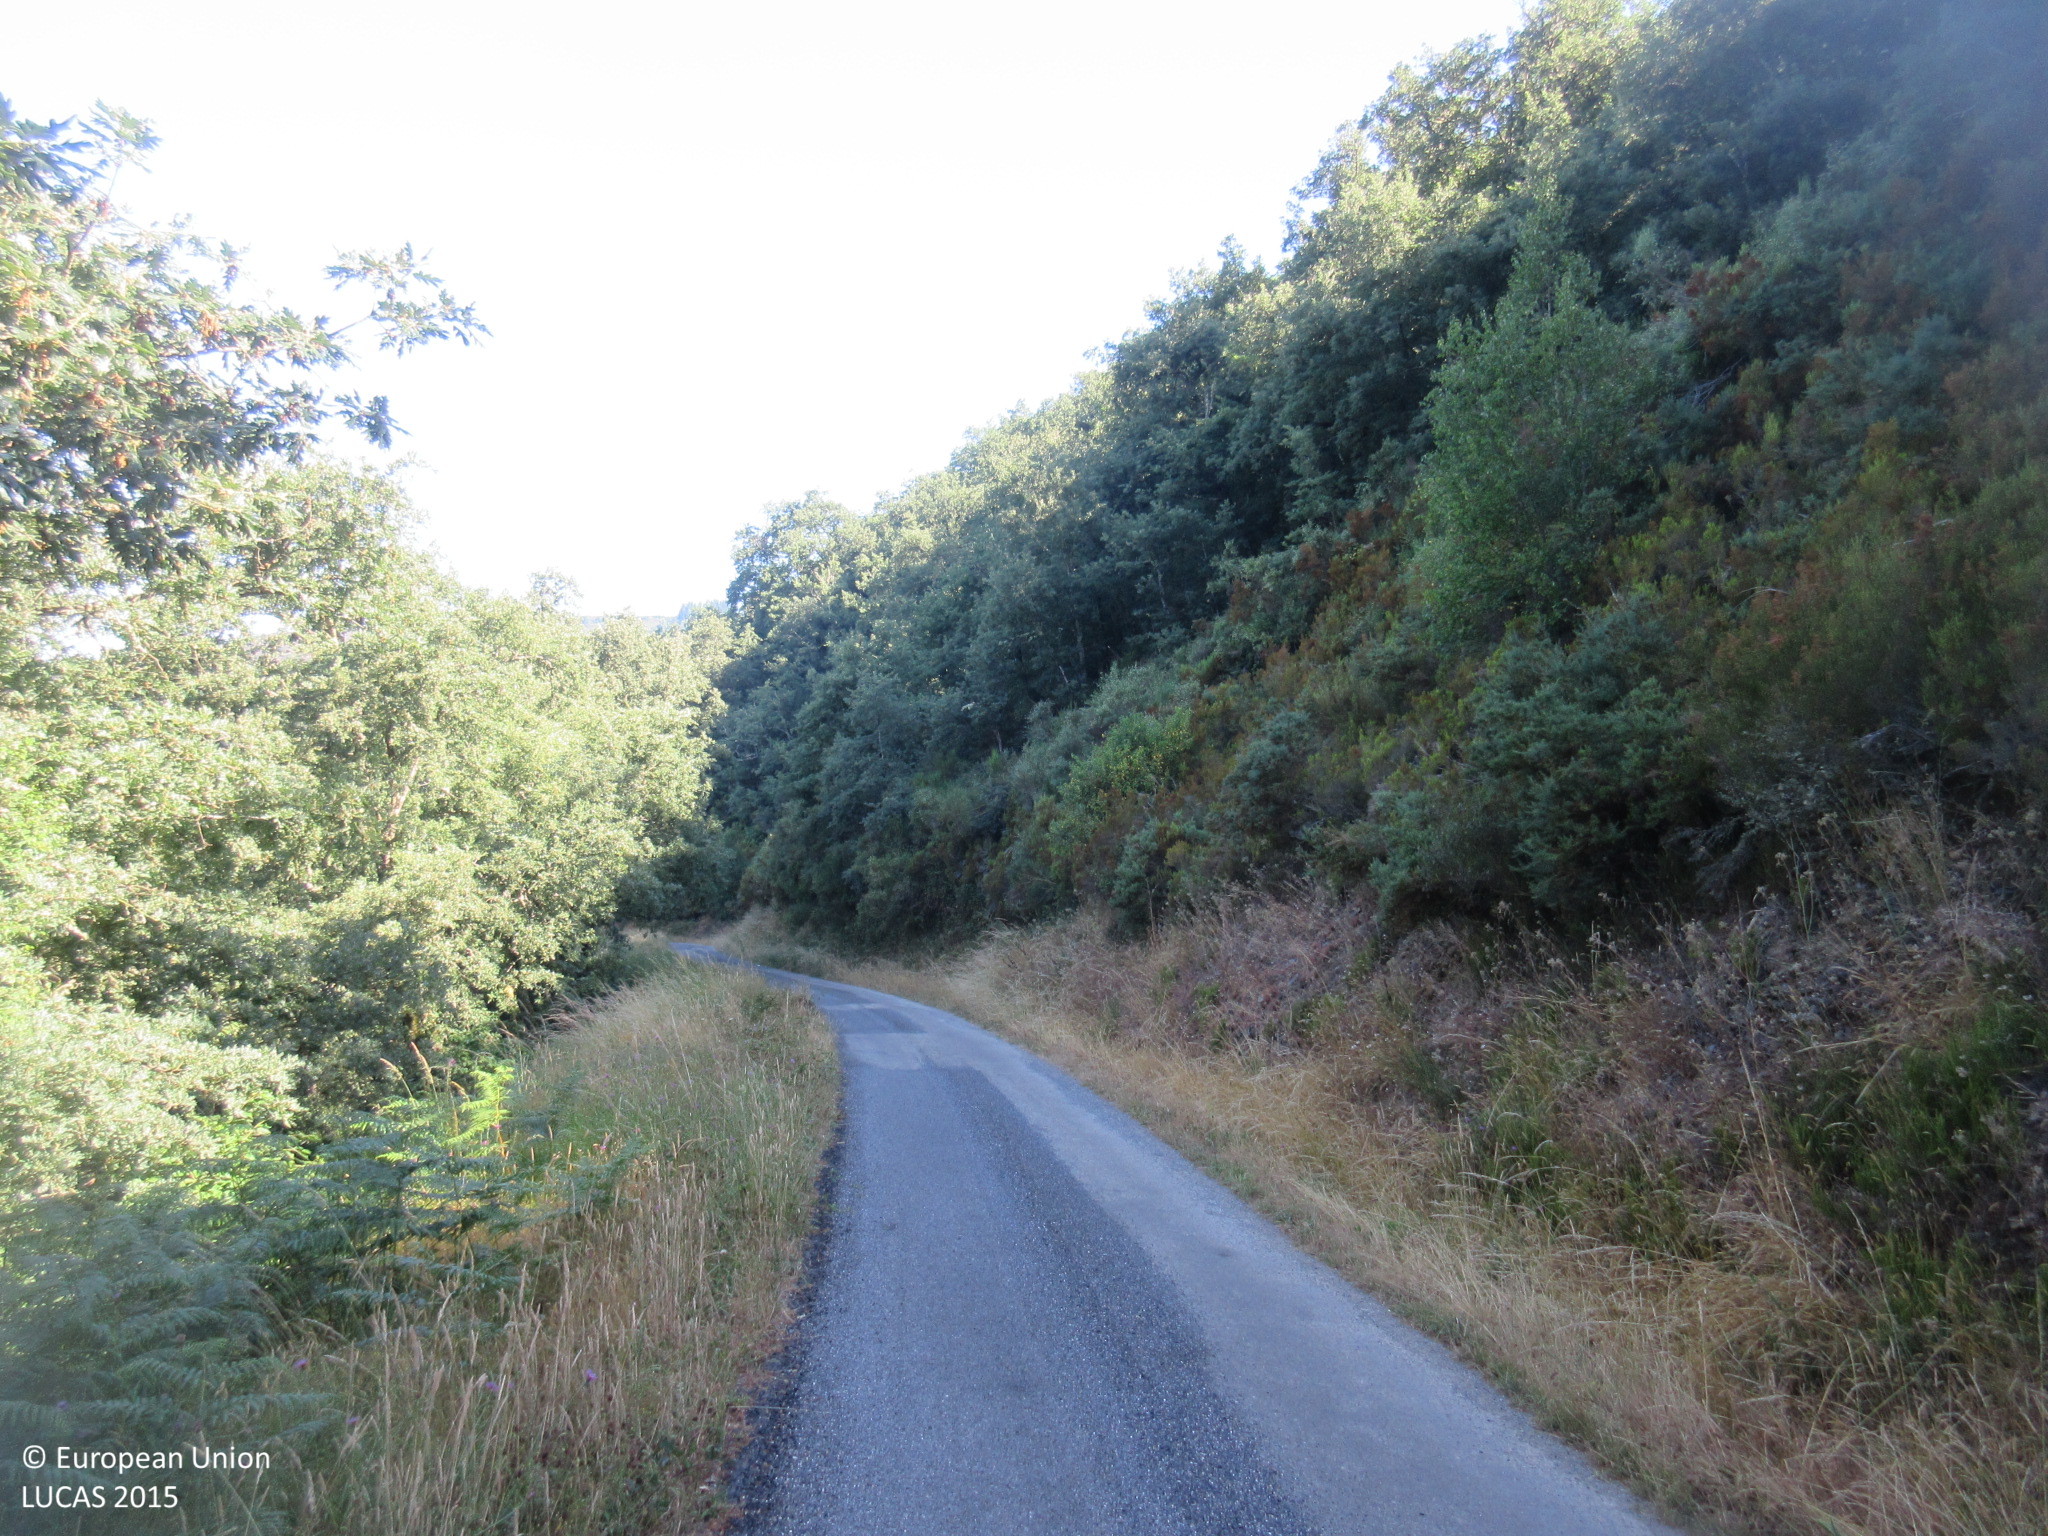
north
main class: Woodland
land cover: Broadleaved woodland
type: acidophilous oak and oak-birch forest
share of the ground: > 75 %
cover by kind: broadleaved forest trees 90 %, shrubs 10 %
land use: Forestry
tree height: > 5 m
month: June
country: ES
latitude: 43.2008
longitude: -7.0619
